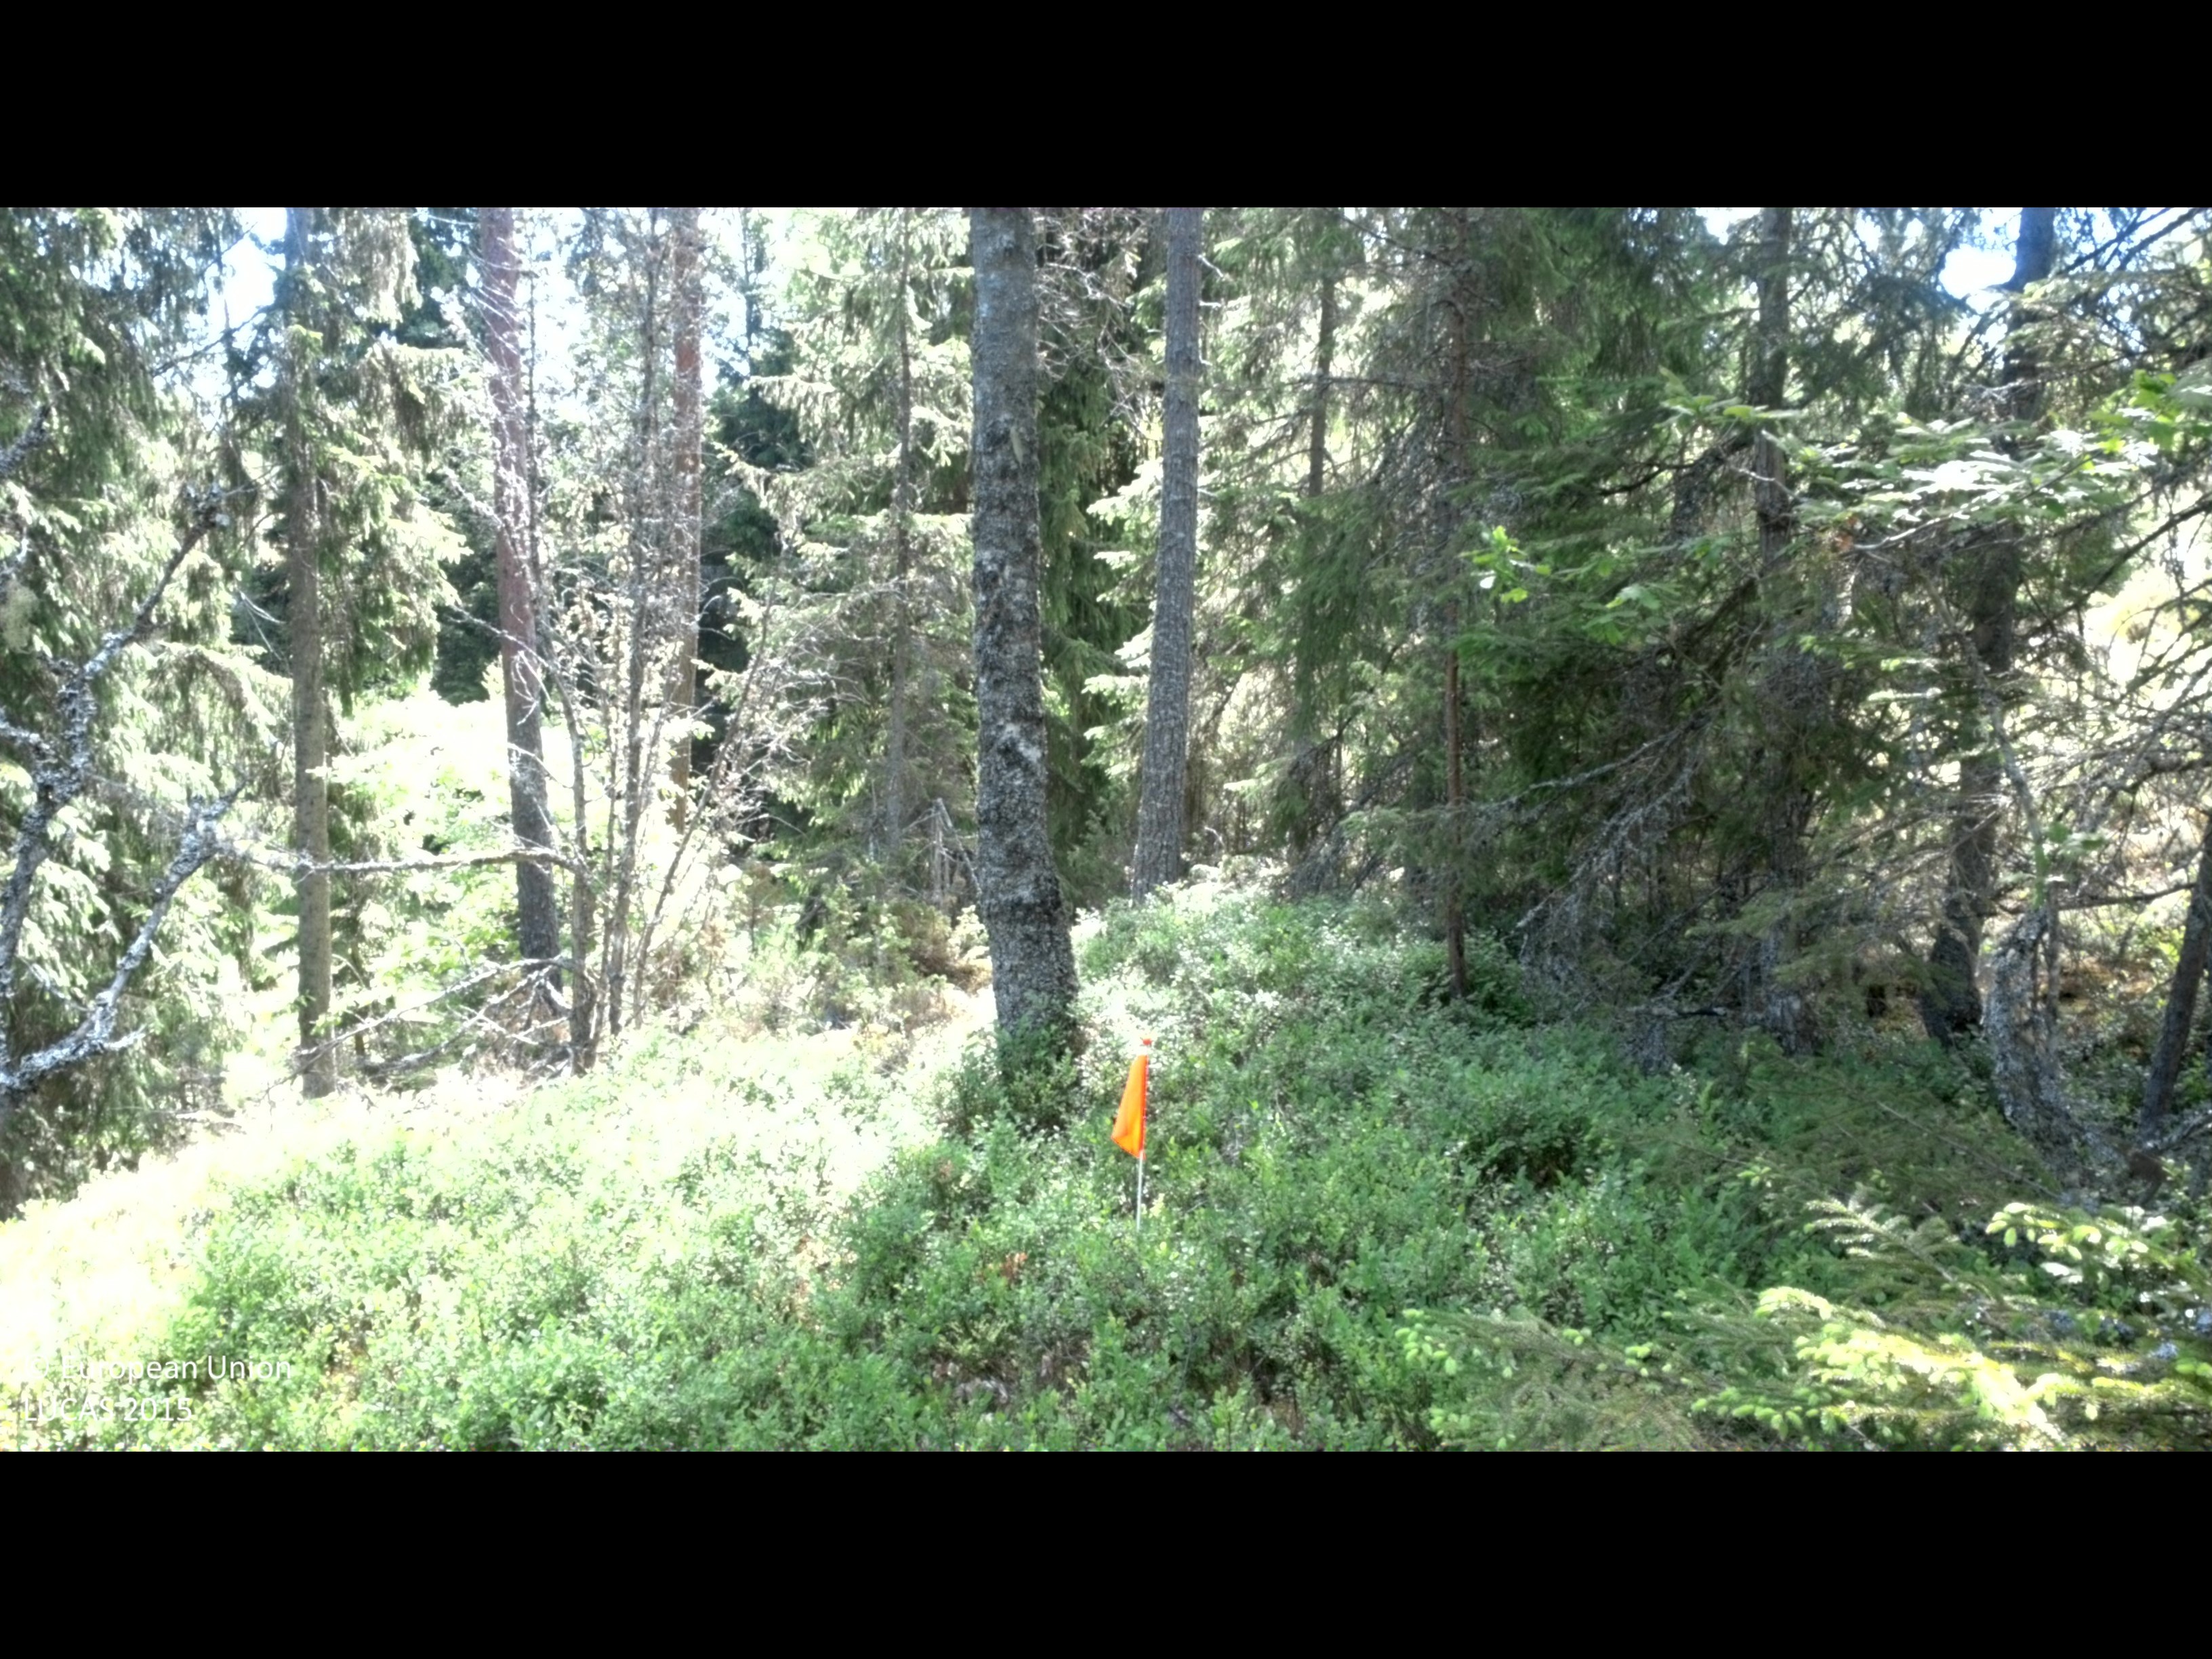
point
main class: Woodland
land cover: Spruce dominated coniferous woodland
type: boreal forest
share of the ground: 50 - 75 %
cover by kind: coniferous forest trees 45 %, shrubs 35 %, broadleaved forest trees 10 %, lichens and mosses 10 %
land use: Forestry
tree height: > 5 m
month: June
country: SE
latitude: 57.6463
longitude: 16.5162
